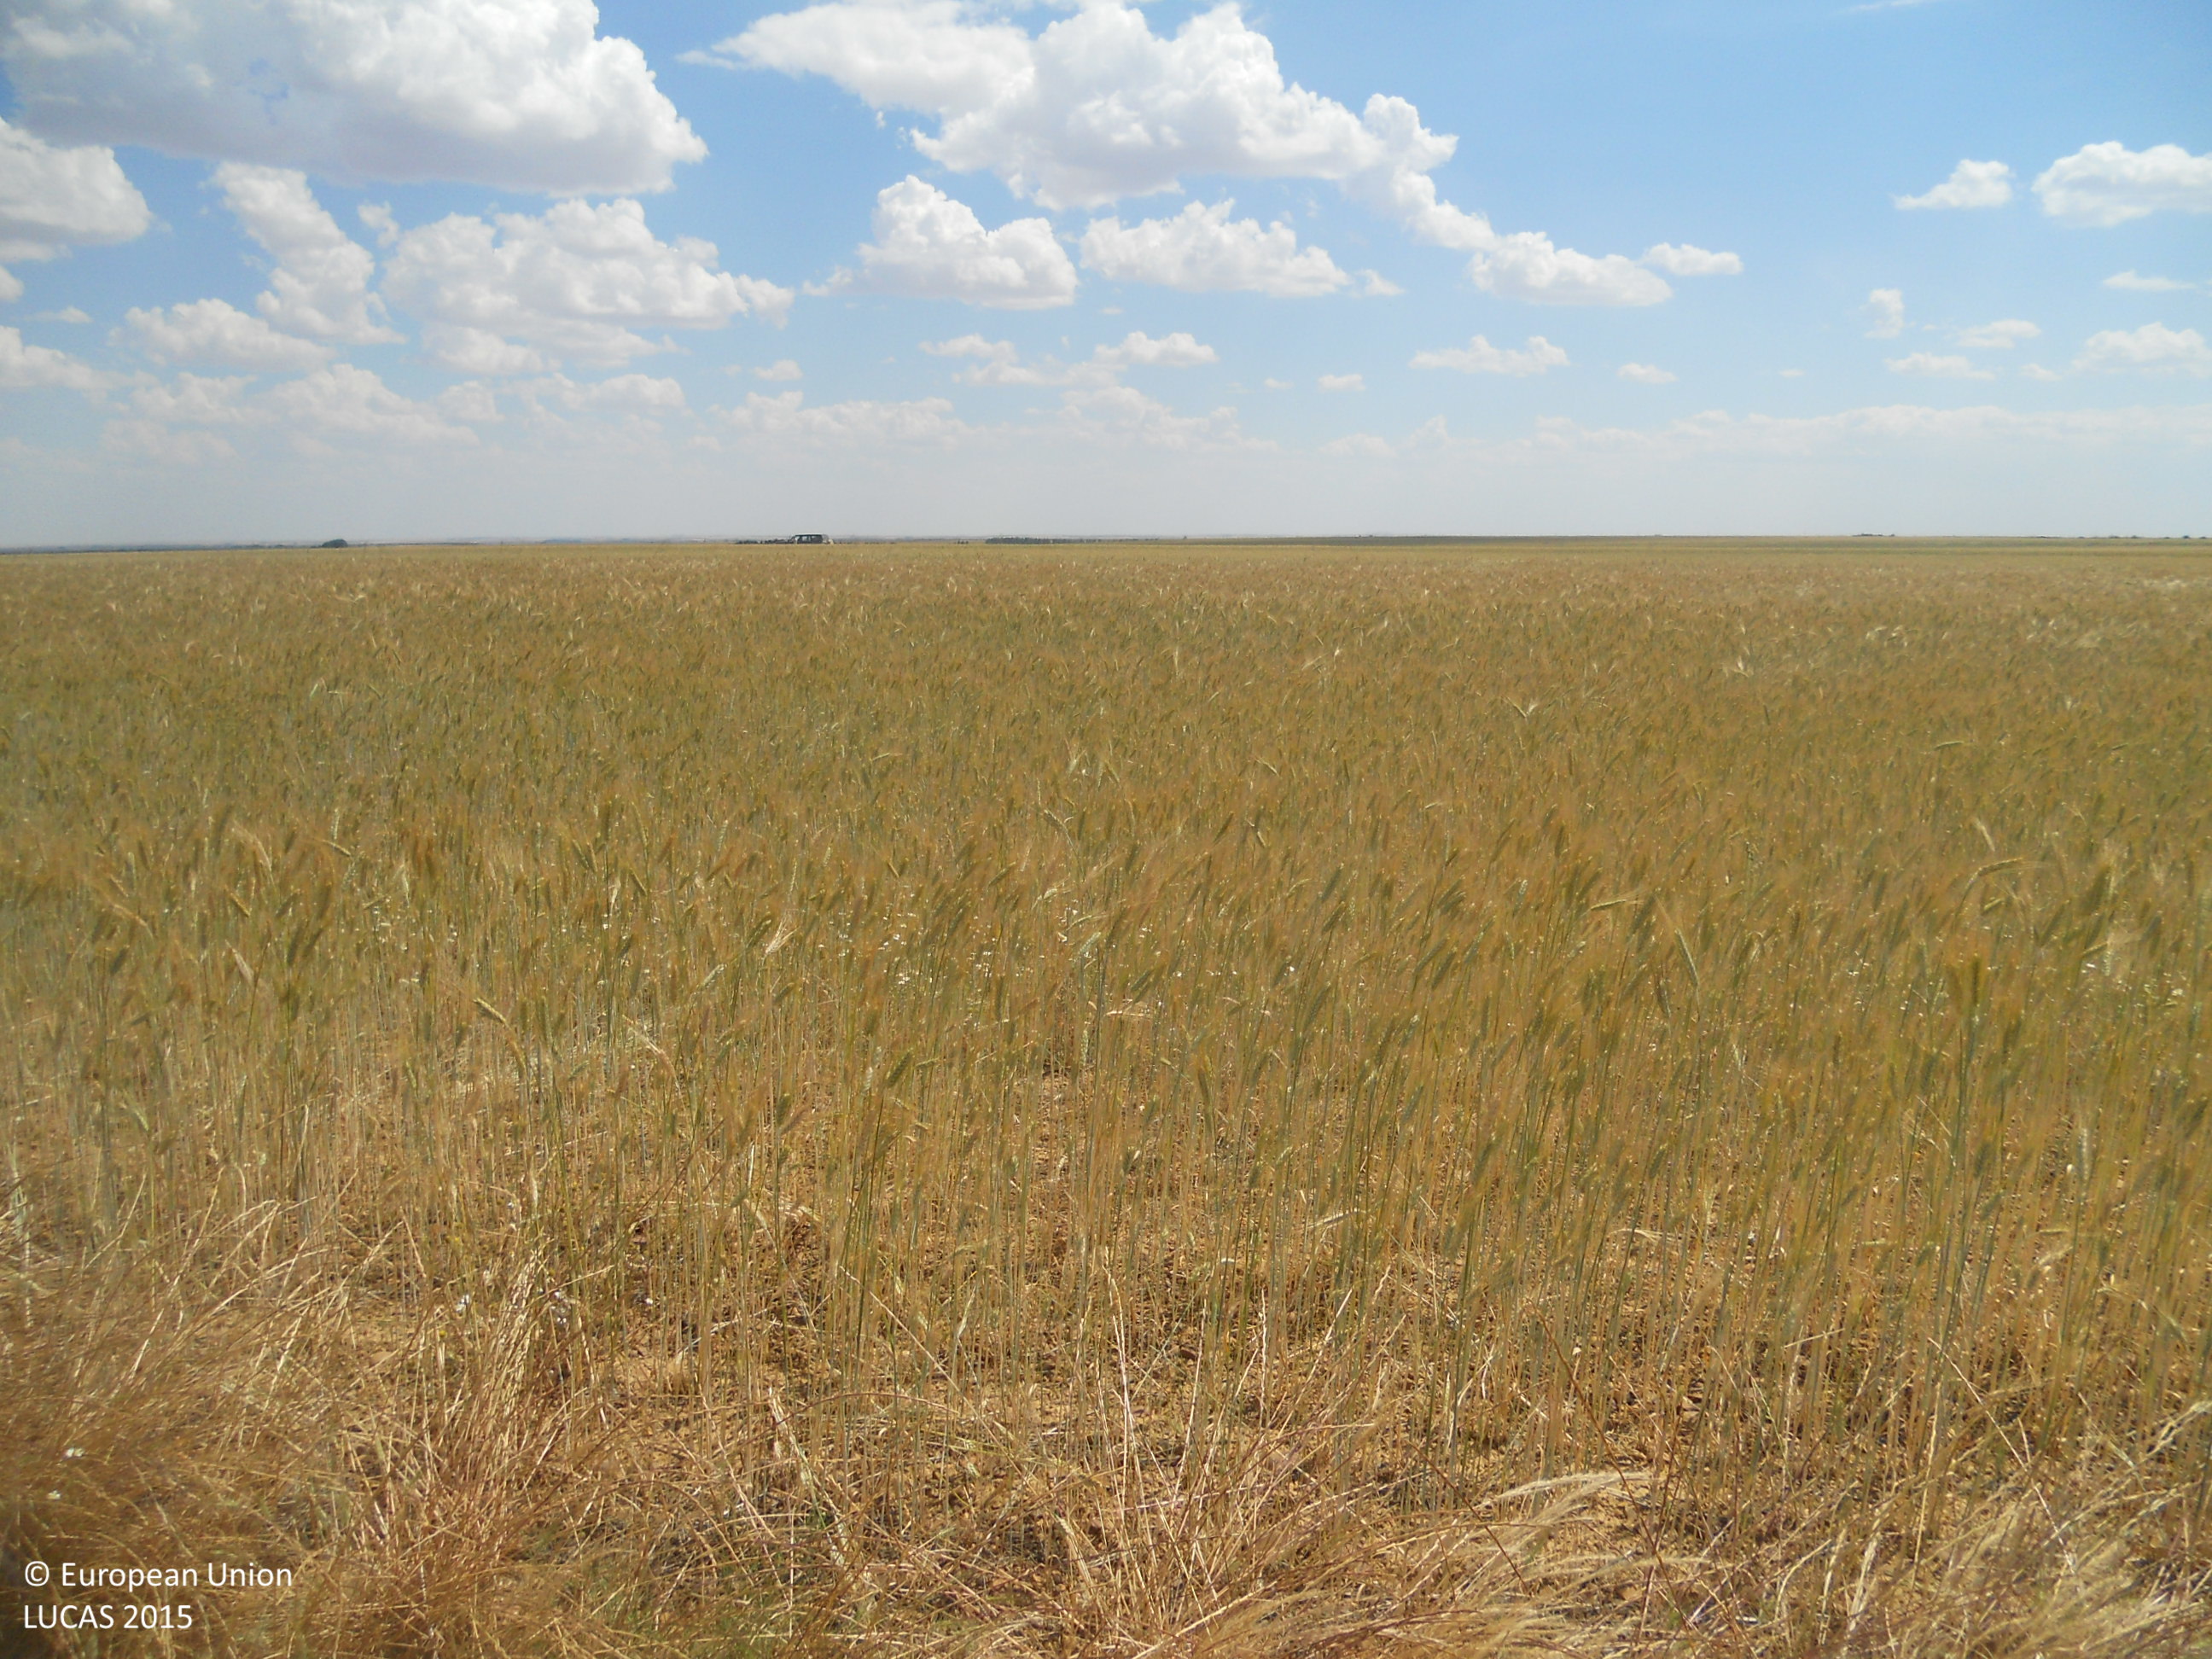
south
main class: Cropland
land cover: Common wheat
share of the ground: > 75 %
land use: Agriculture (excluding fallow land and kitchen gardens)
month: June
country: ES
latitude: 42.2823
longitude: -5.3562
